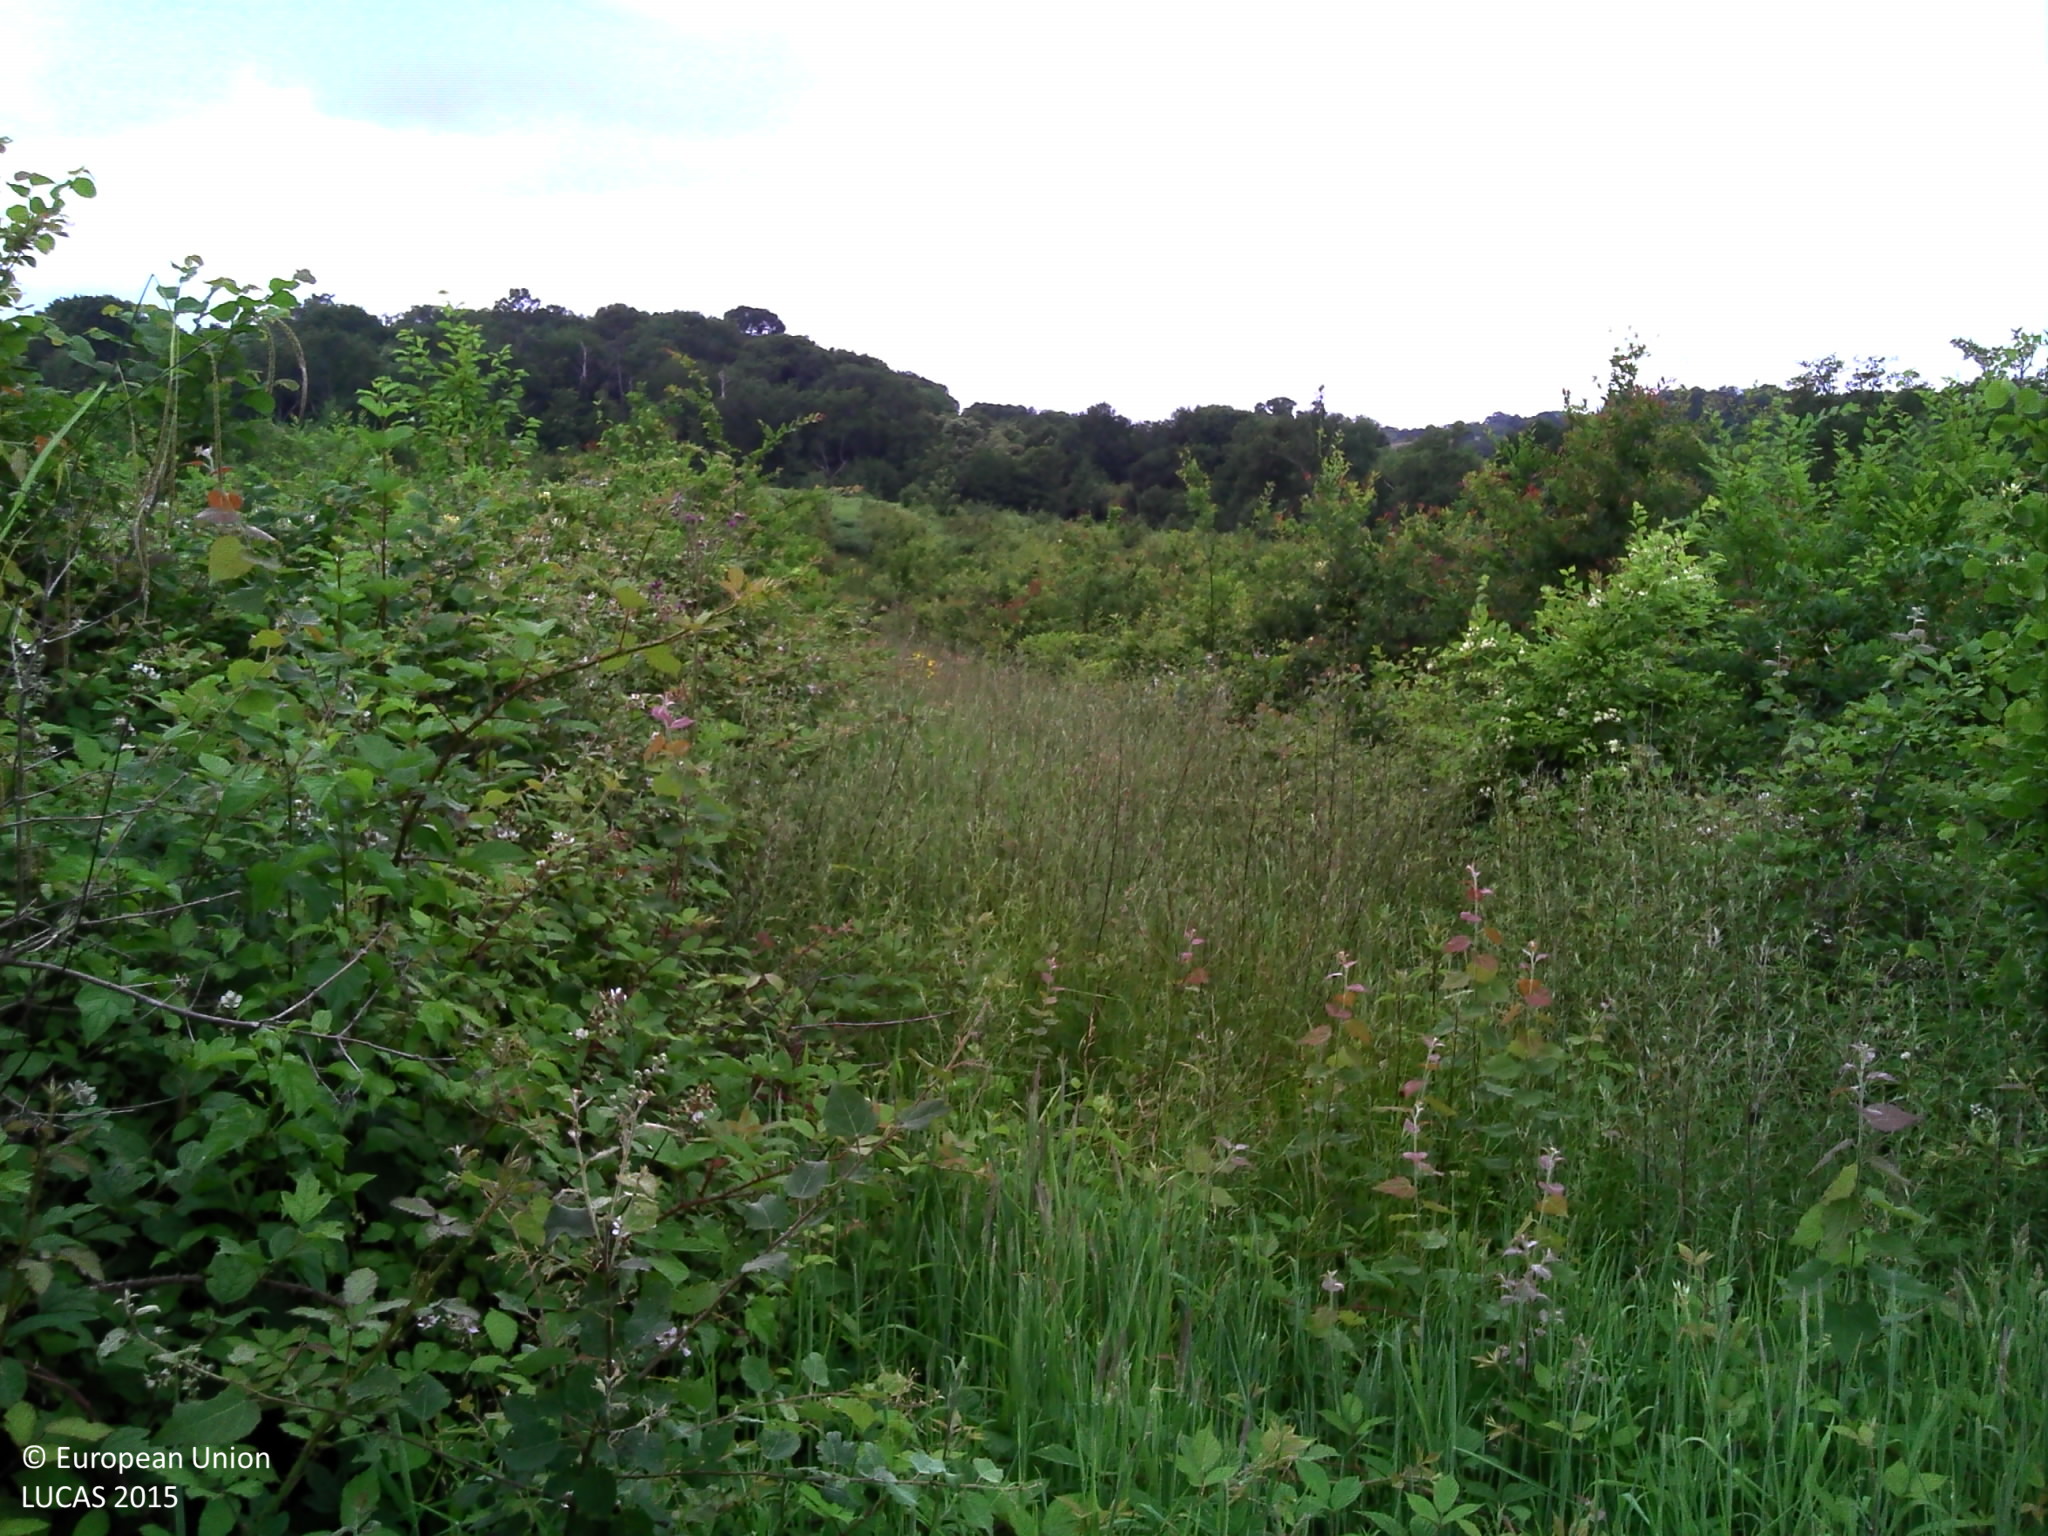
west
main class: Shrubland
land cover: Shrubland without tree cover
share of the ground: > 75 %
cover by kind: shrubs 70 %, herbaceous plants 30 %
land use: Semi-natural and natural areas not in use
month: June
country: FR
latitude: 43.7707
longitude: -0.2331
